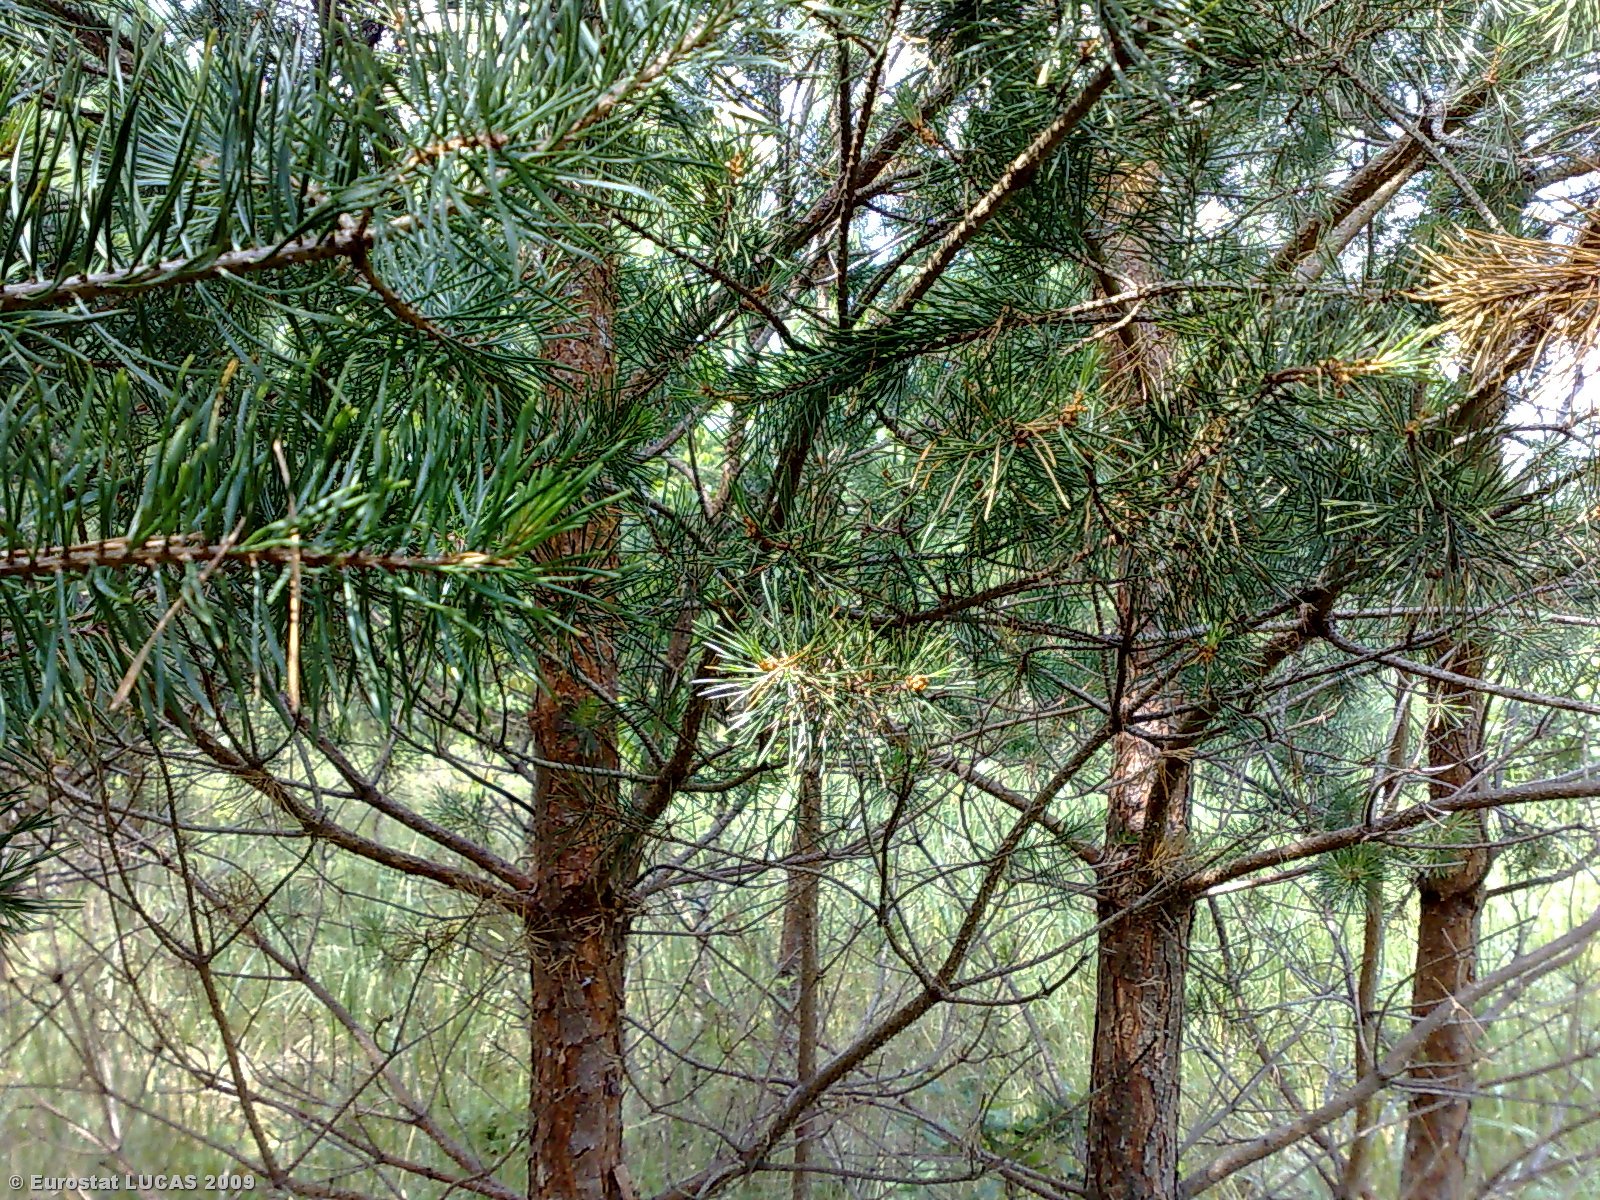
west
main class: Woodland
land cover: Coniferous woodland
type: hemiboreal forest and nemoral coniferous forest and mixed broadleaved-coniferous forest
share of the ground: > 75 %
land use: Forestry
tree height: > 5 m
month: July
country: LT
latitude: 55.5618
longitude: 22.7979
